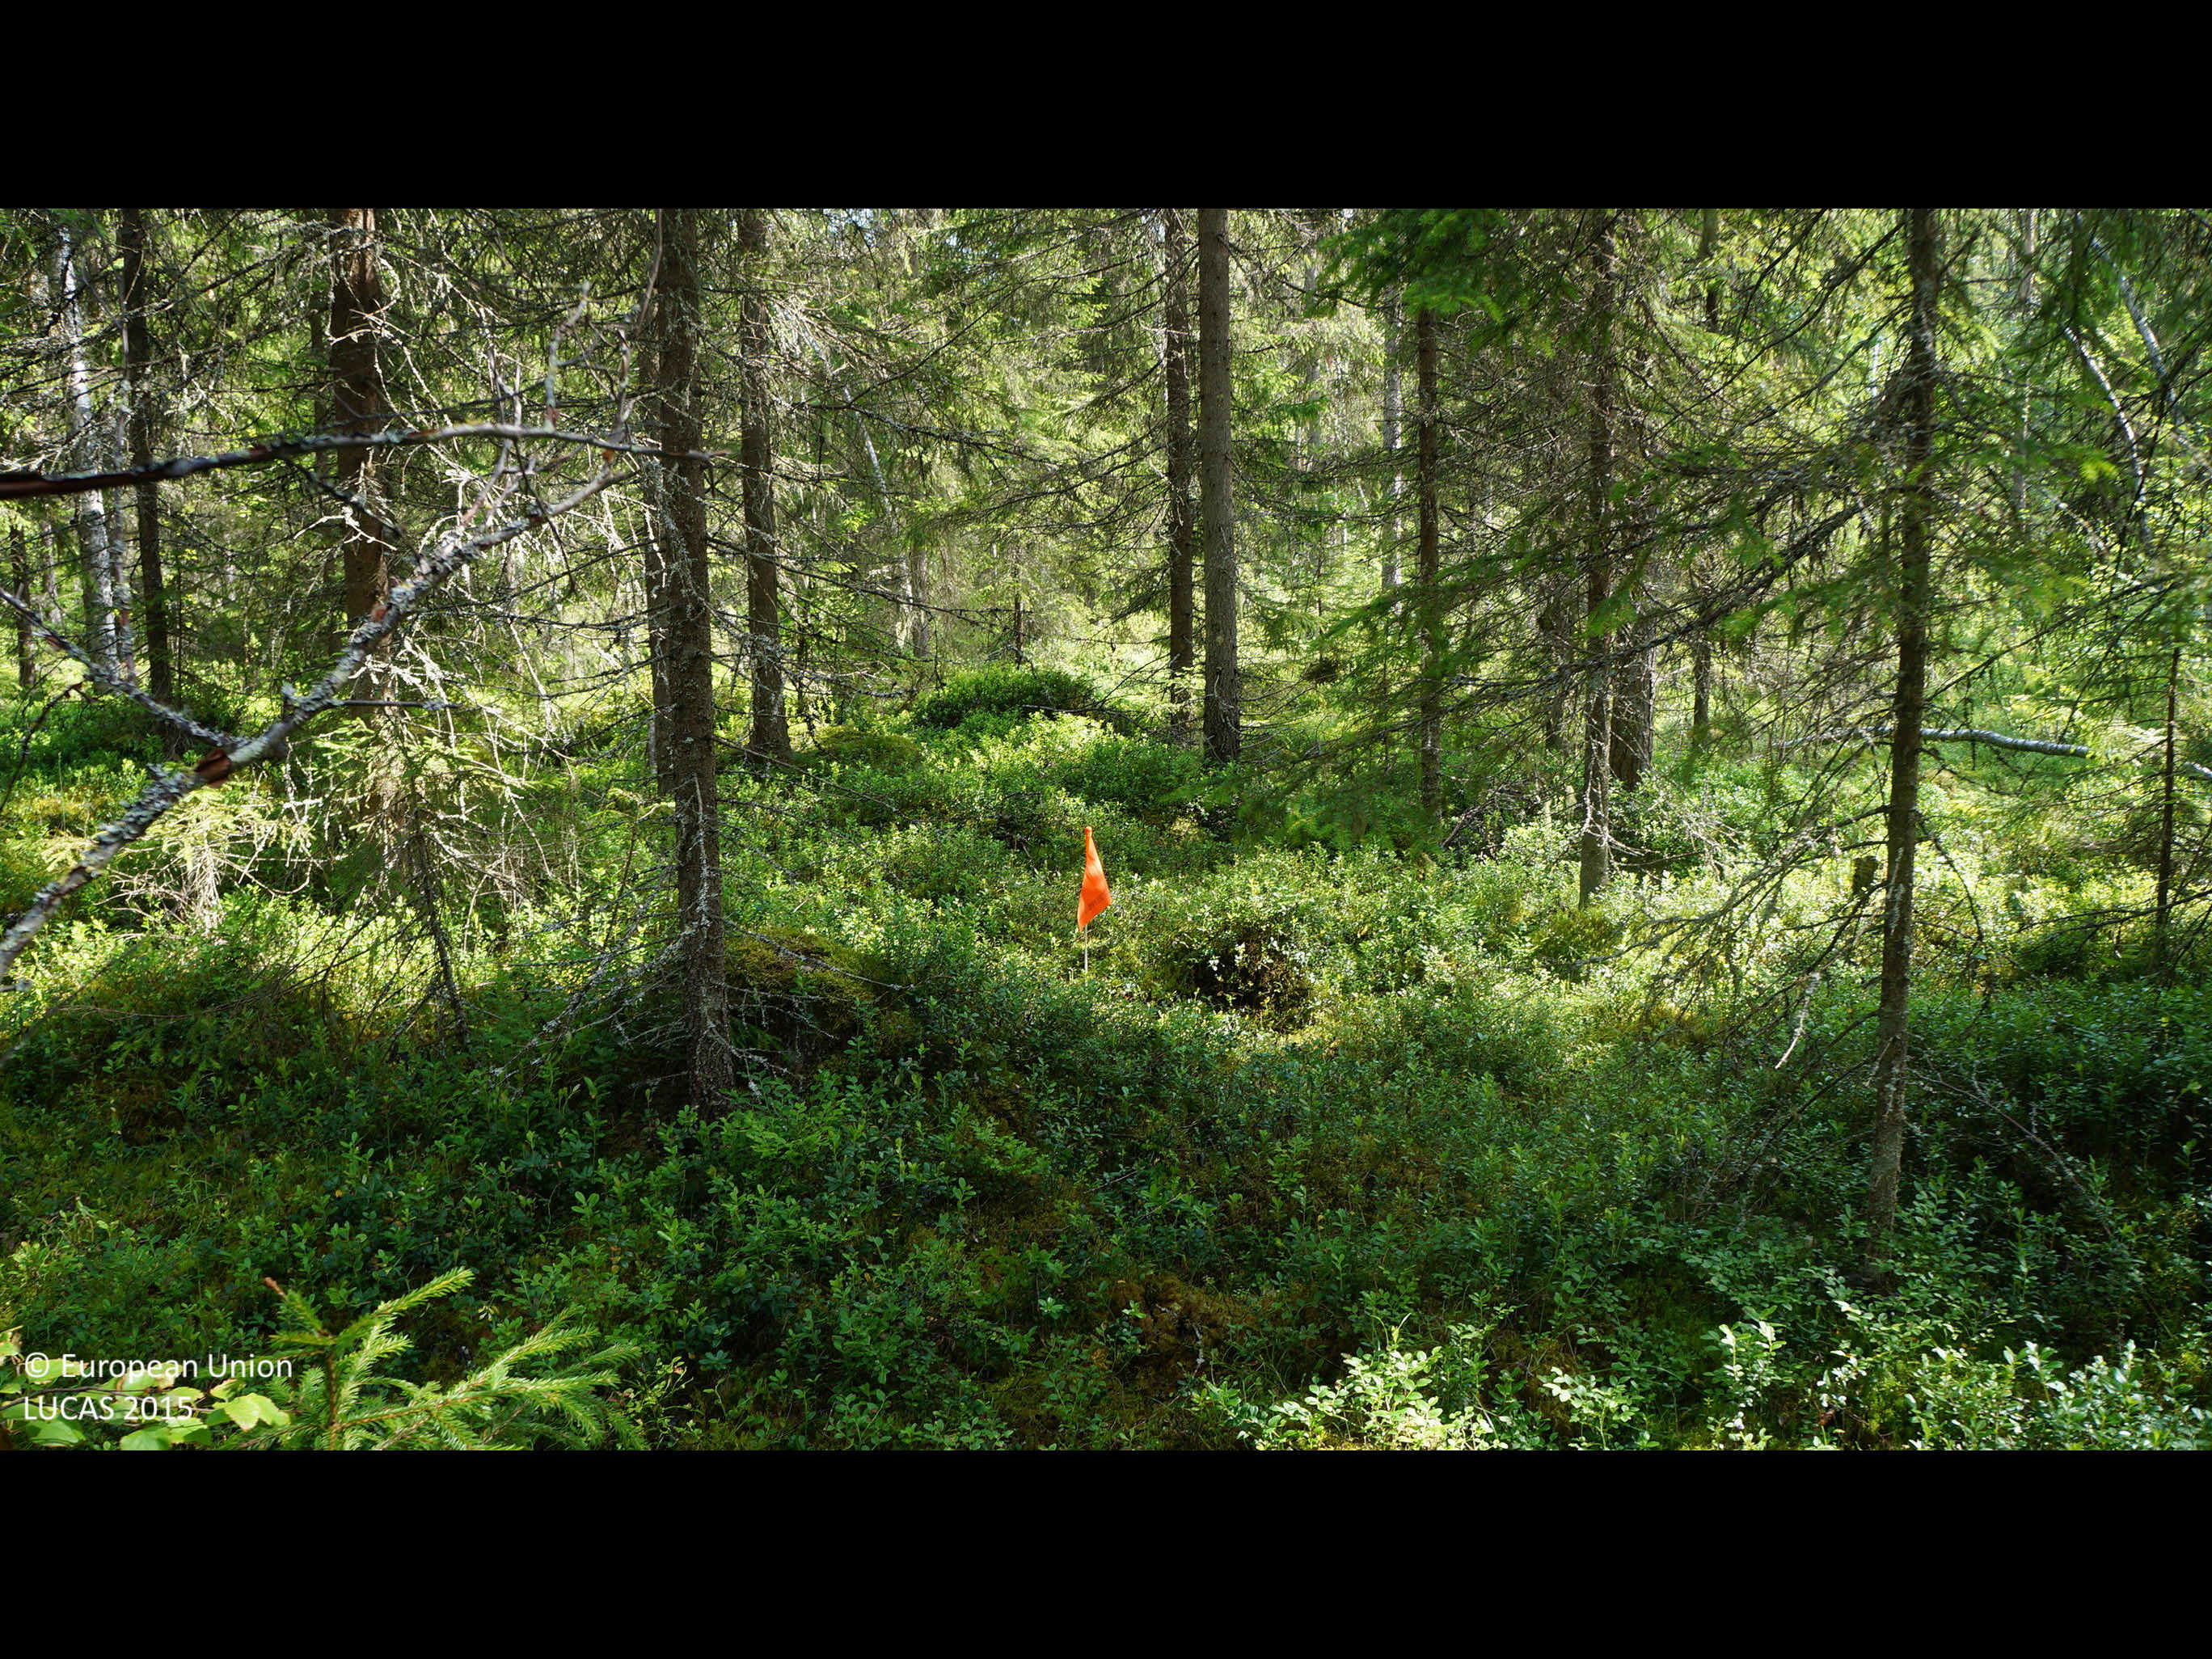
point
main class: Woodland
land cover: Spruce dominated coniferous woodland
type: boreal forest
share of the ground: > 75 %
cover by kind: coniferous forest trees 70 %, shrubs 20 %, broadleaved forest trees 5 %, lichens and mosses 5 %
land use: Forestry
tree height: > 5 m
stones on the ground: < 10 %
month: July
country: FI
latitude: 64.1924
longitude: 24.2527
